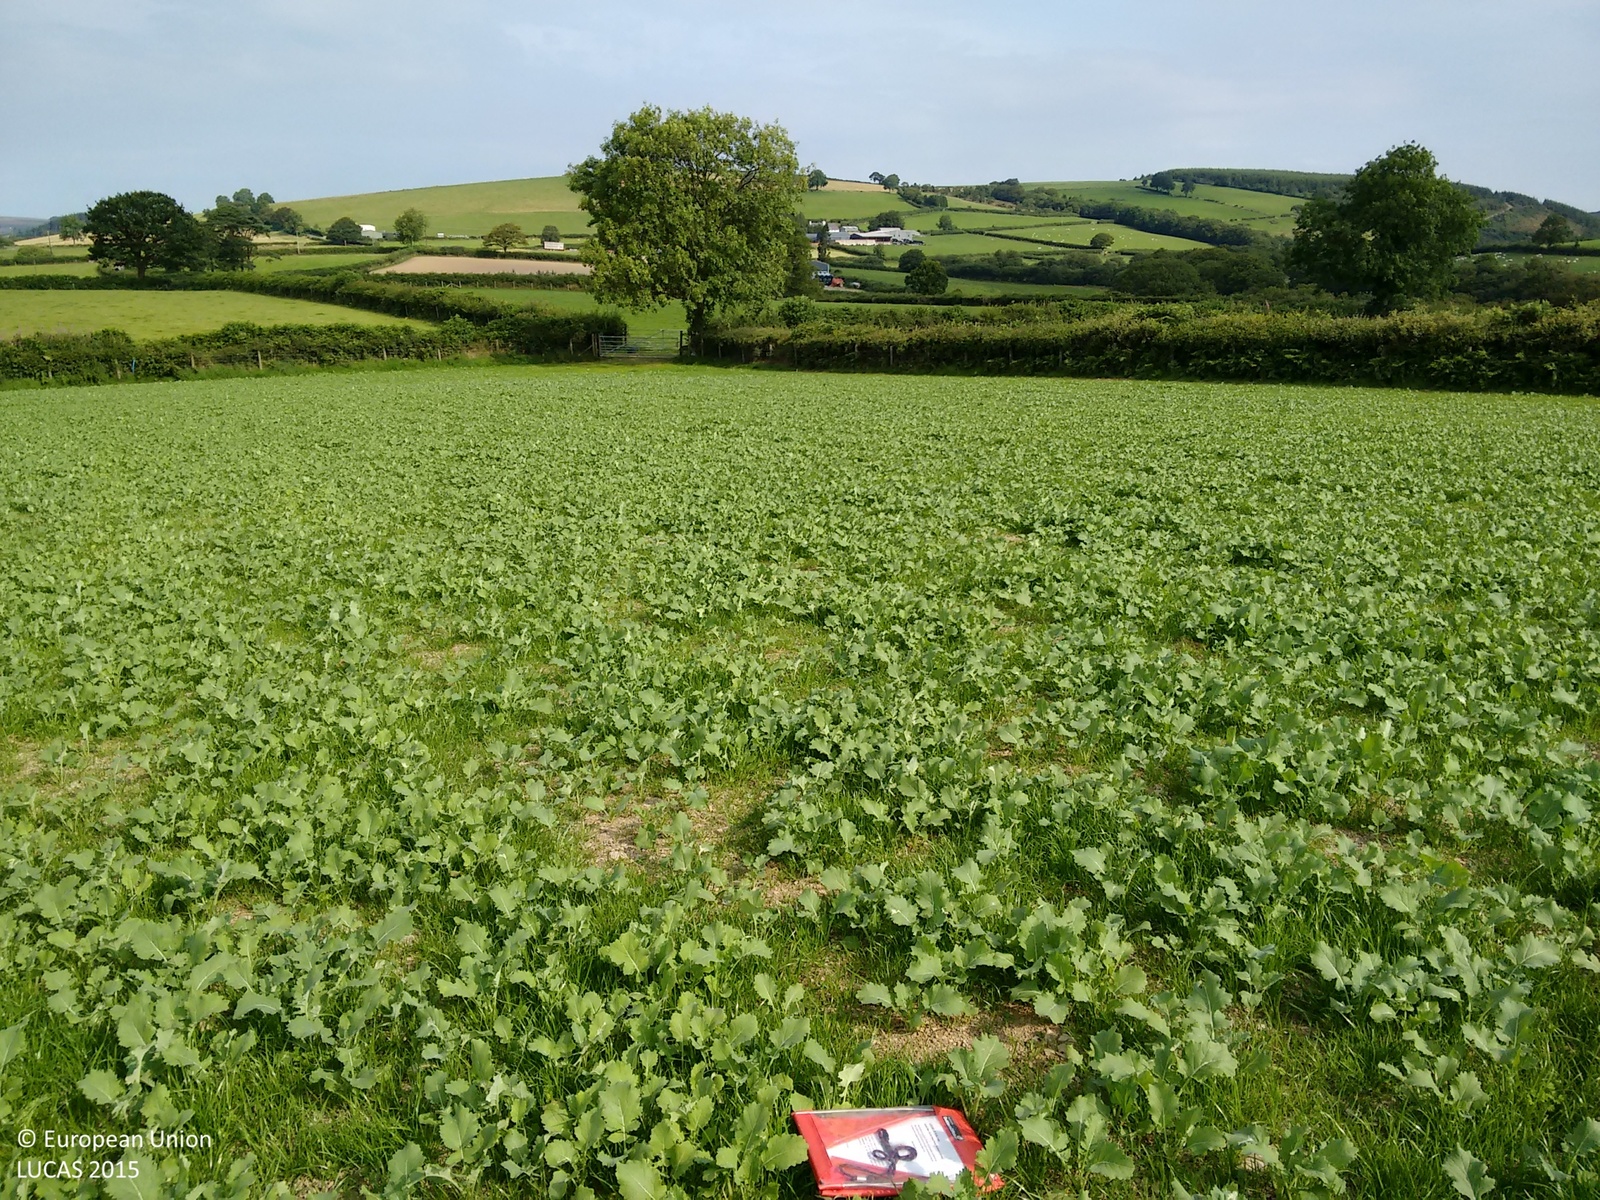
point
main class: Cropland
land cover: Sugar beet
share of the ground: > 75 %
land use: Agriculture (excluding fallow land and kitchen gardens)
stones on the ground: 10 - 25 %
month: August
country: GB
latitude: 52.0158
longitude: -4.0101
